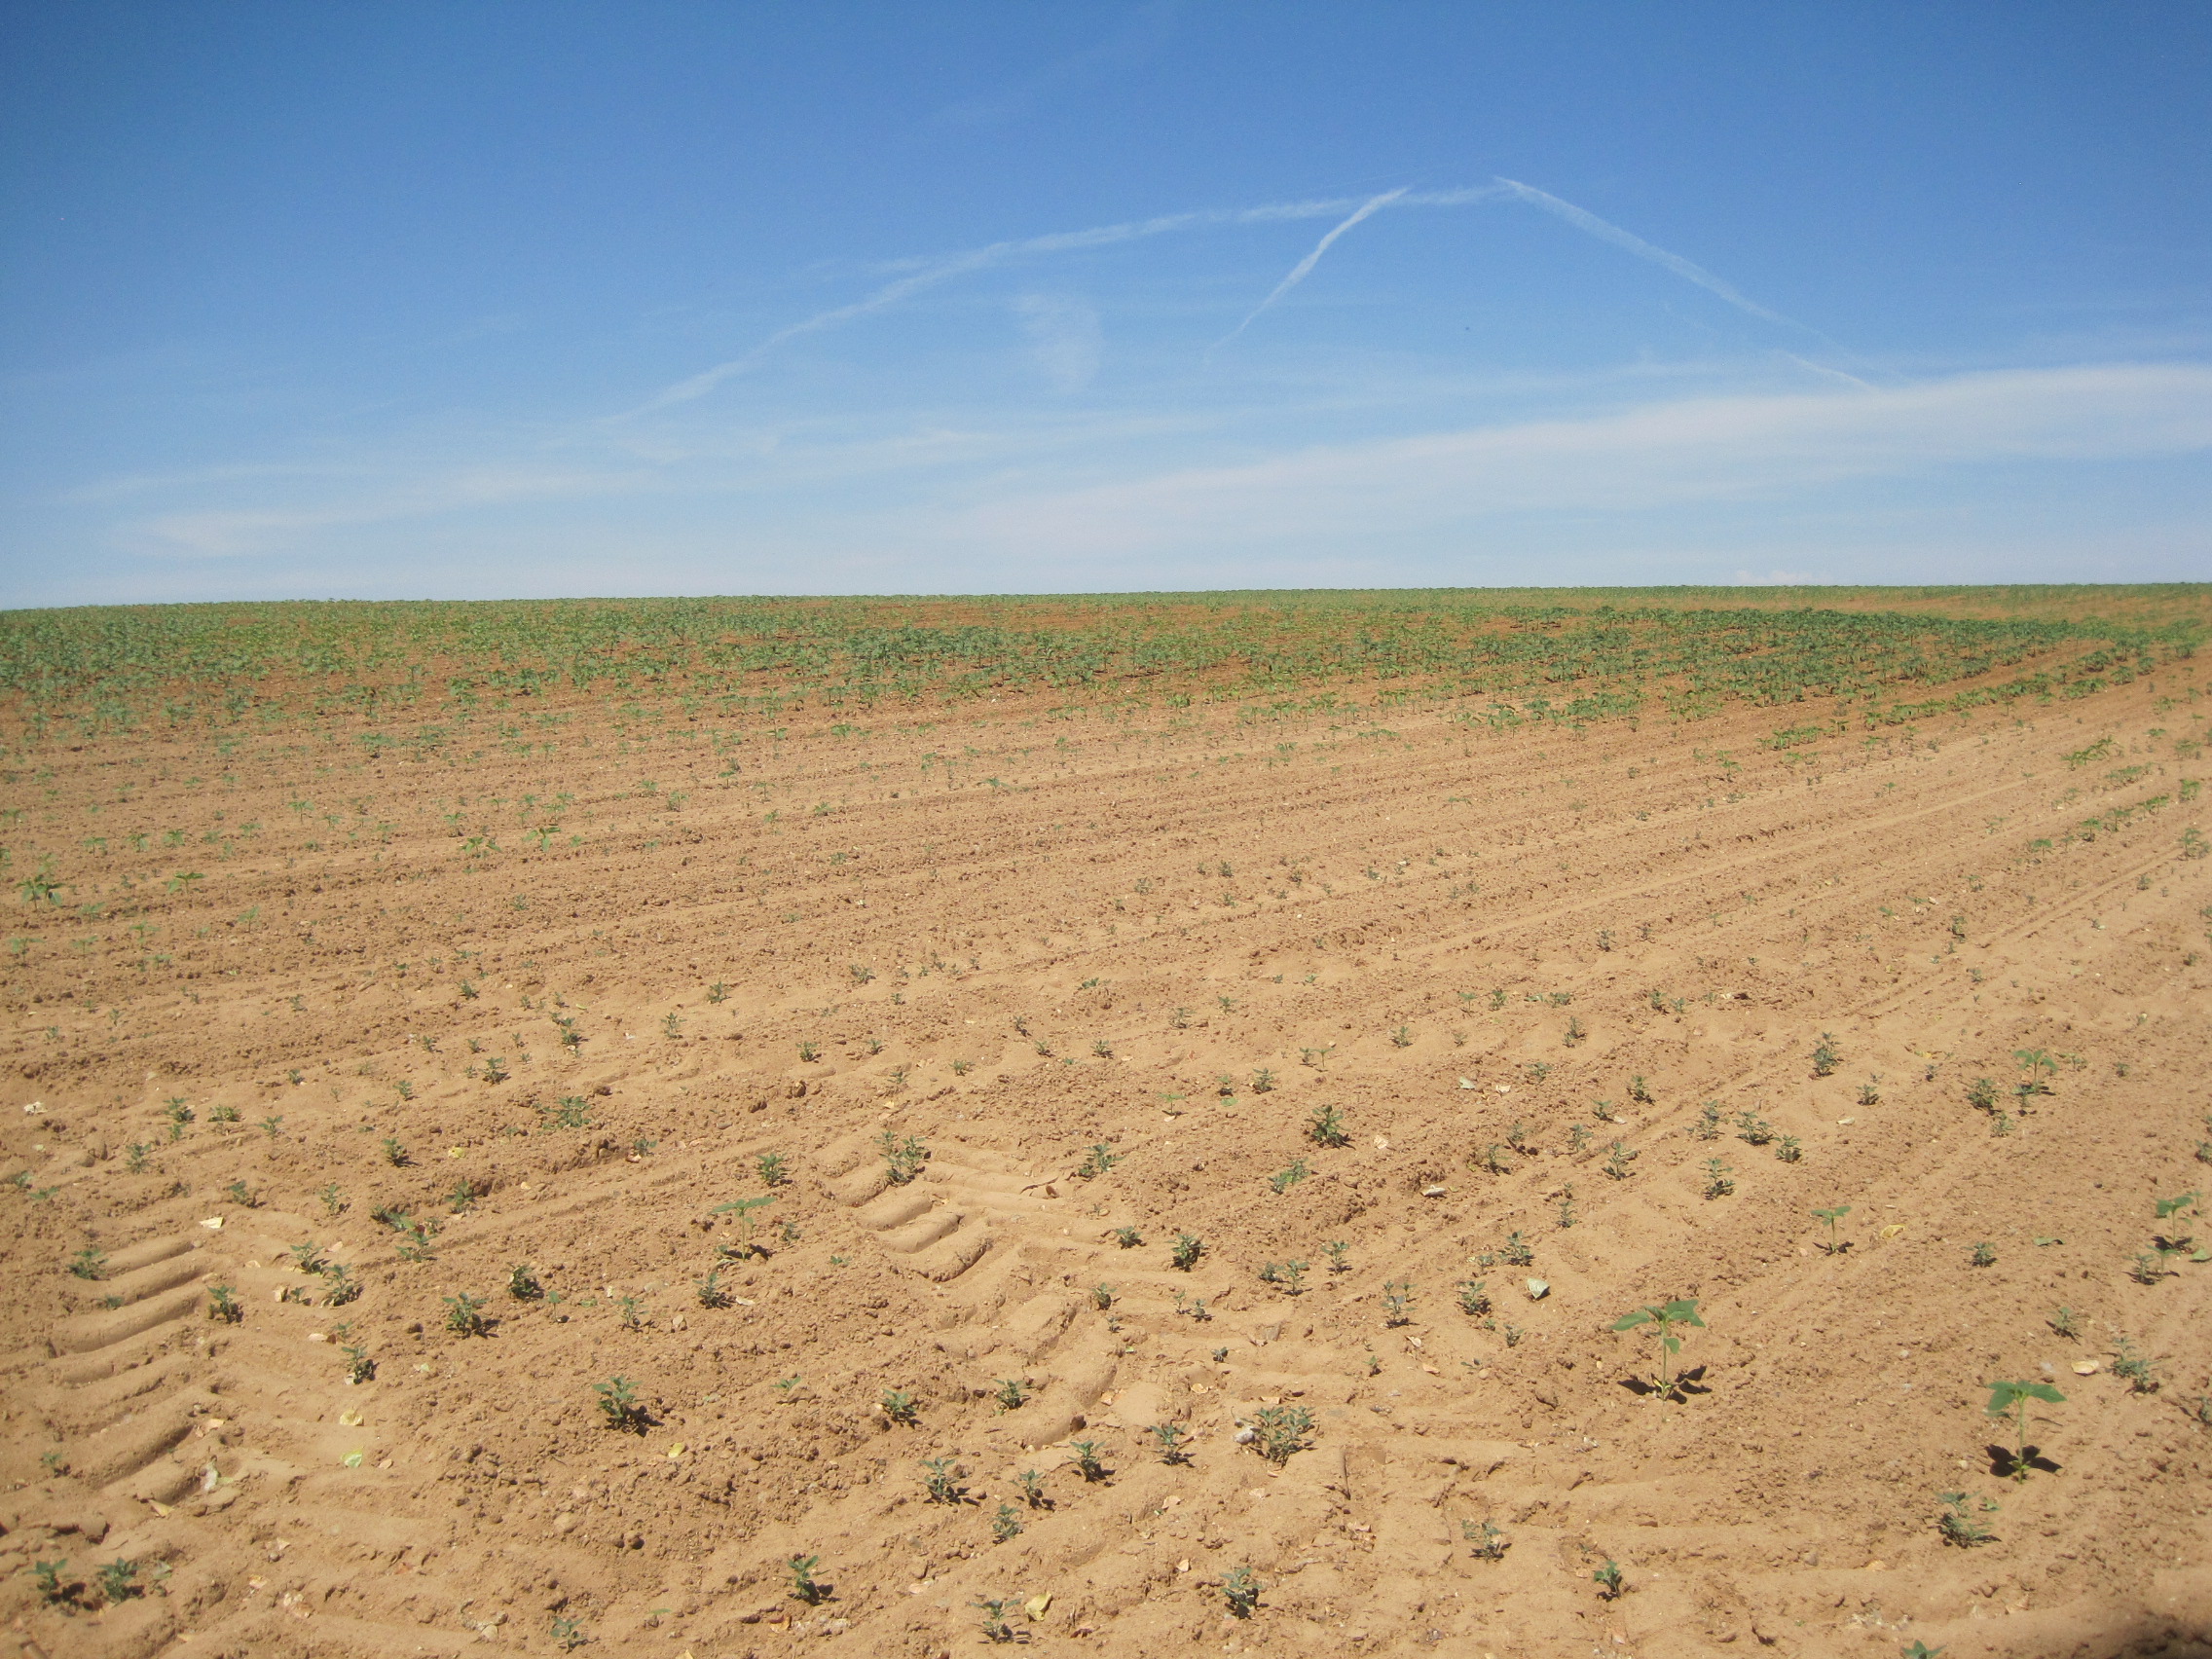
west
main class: Cropland
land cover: Sunflower
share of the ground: < 10 %
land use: Agriculture (excluding fallow land and kitchen gardens)
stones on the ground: 10 - 25 %
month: June
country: ES
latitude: 41.4171
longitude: -5.1364
